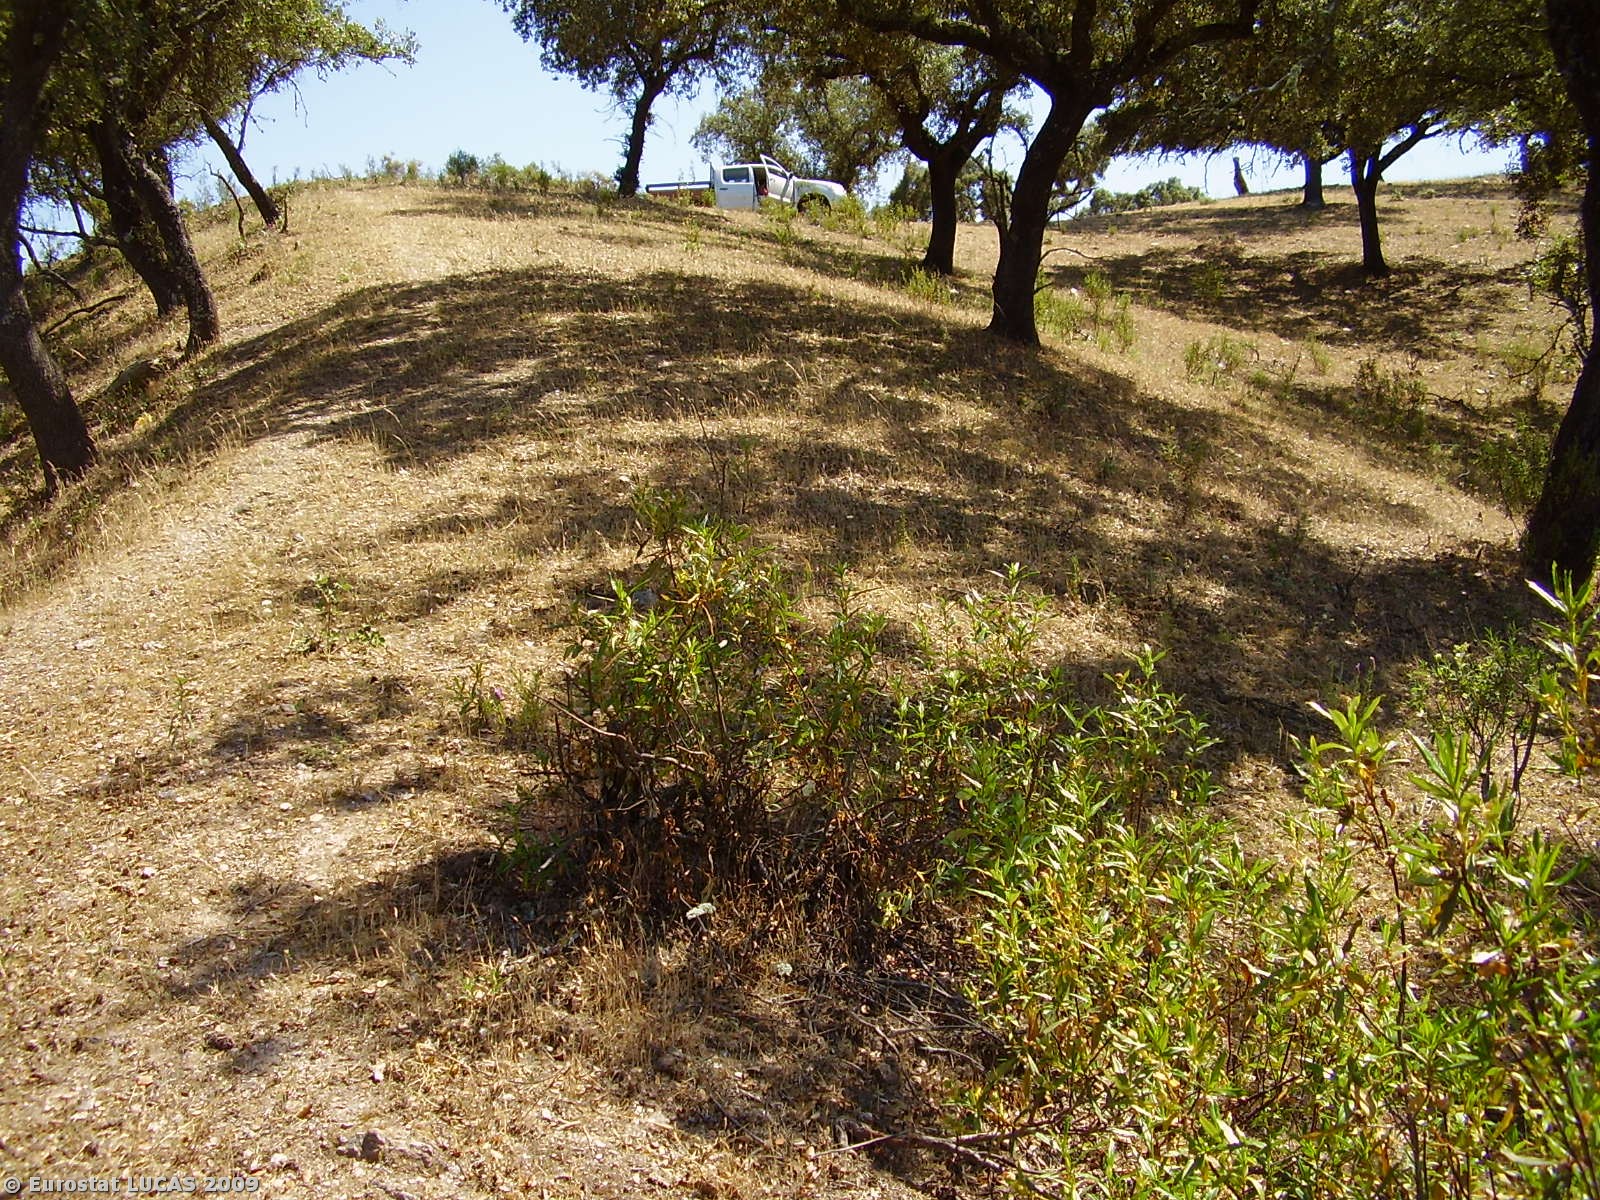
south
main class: Woodland
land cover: Broadleaved woodland
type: broadleaved evergreen forest
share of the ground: 50 - 75 %
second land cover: Bare land
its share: 25 - 50 %
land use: Forestry
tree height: > 5 m
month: May
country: PT
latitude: 37.8686
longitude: -7.7908
